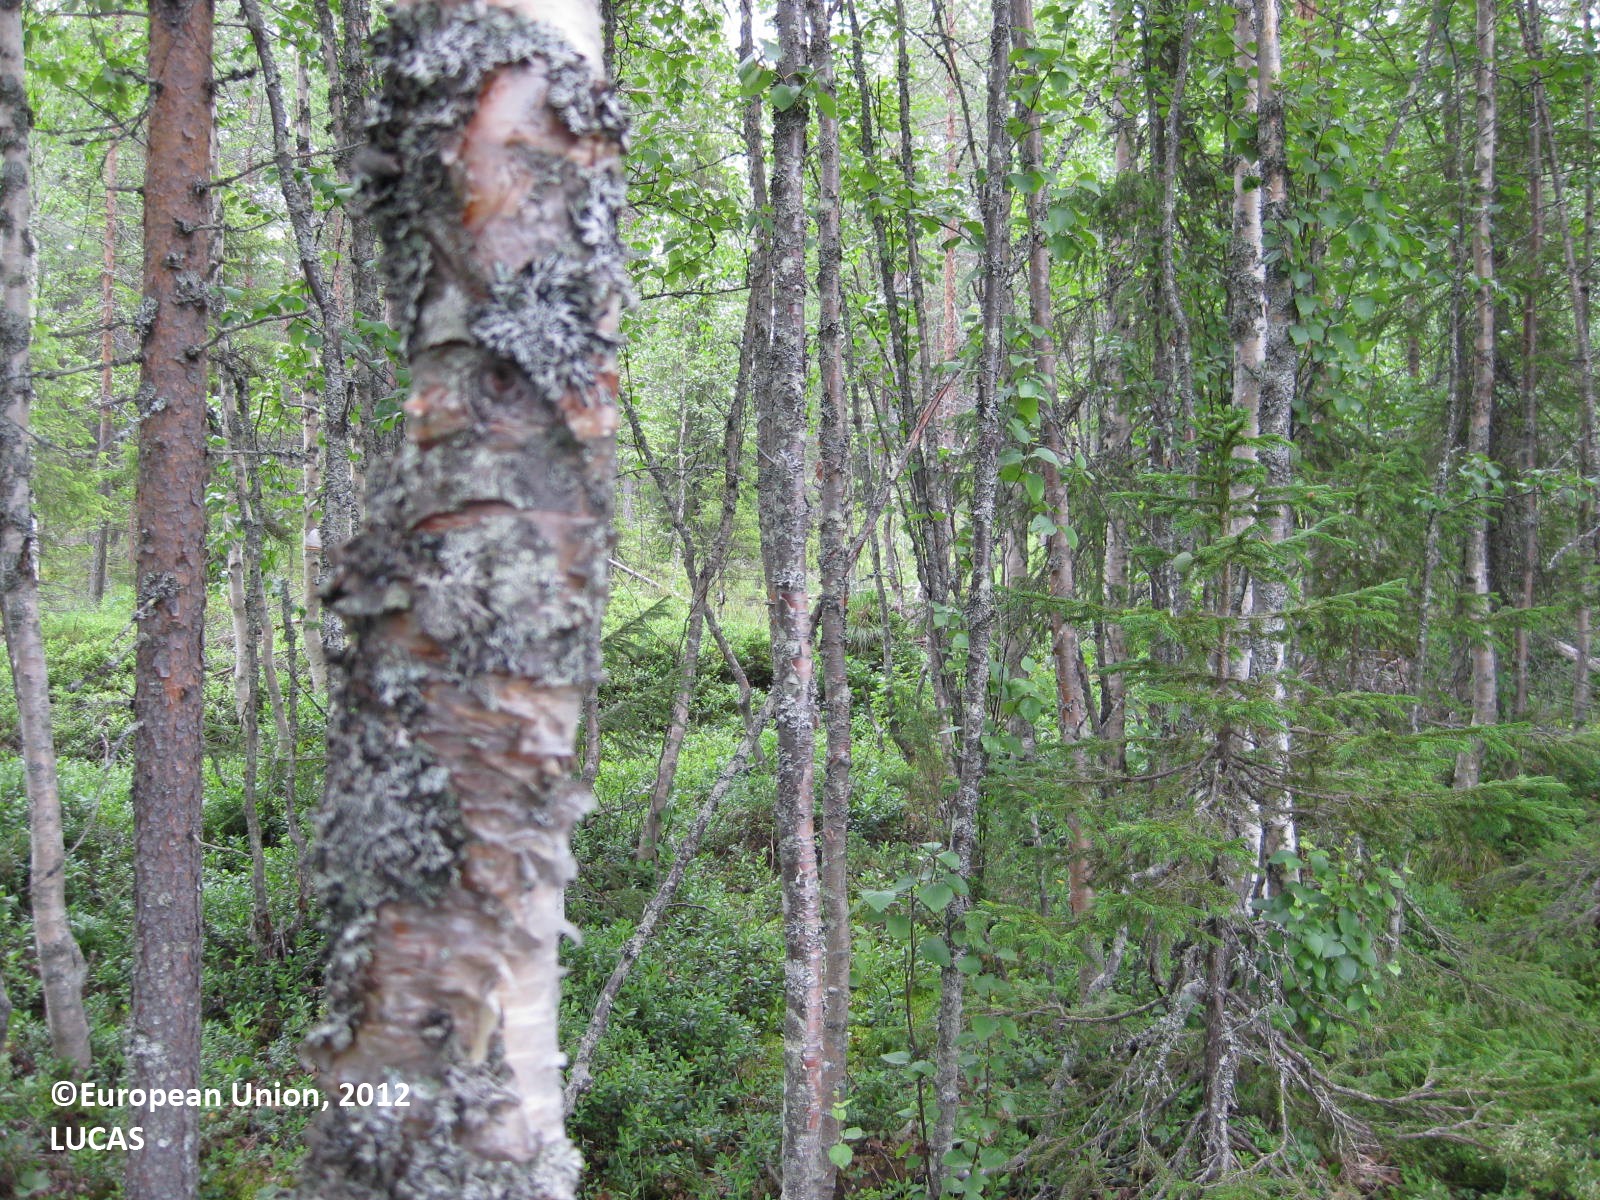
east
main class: Woodland
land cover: Pine dominated mixed woodland
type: boreal forest
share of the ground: > 75 %
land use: Forestry
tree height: > 5 m
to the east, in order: Pine dominated mixed woodland; Other coniferous woodland; Pine dominated mixed woodland; Pine dominated coniferous woodland; Ponds and wetlands; Pine dominated coniferous woodland; Ponds and wetlands; Pine dominated coniferous woodland; Ponds and wetlands; Pine dominated coniferous woodland; Other coniferous woodland; Pine dominated mixed woodland
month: July
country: FI
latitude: 65.9063
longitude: 29.6707
